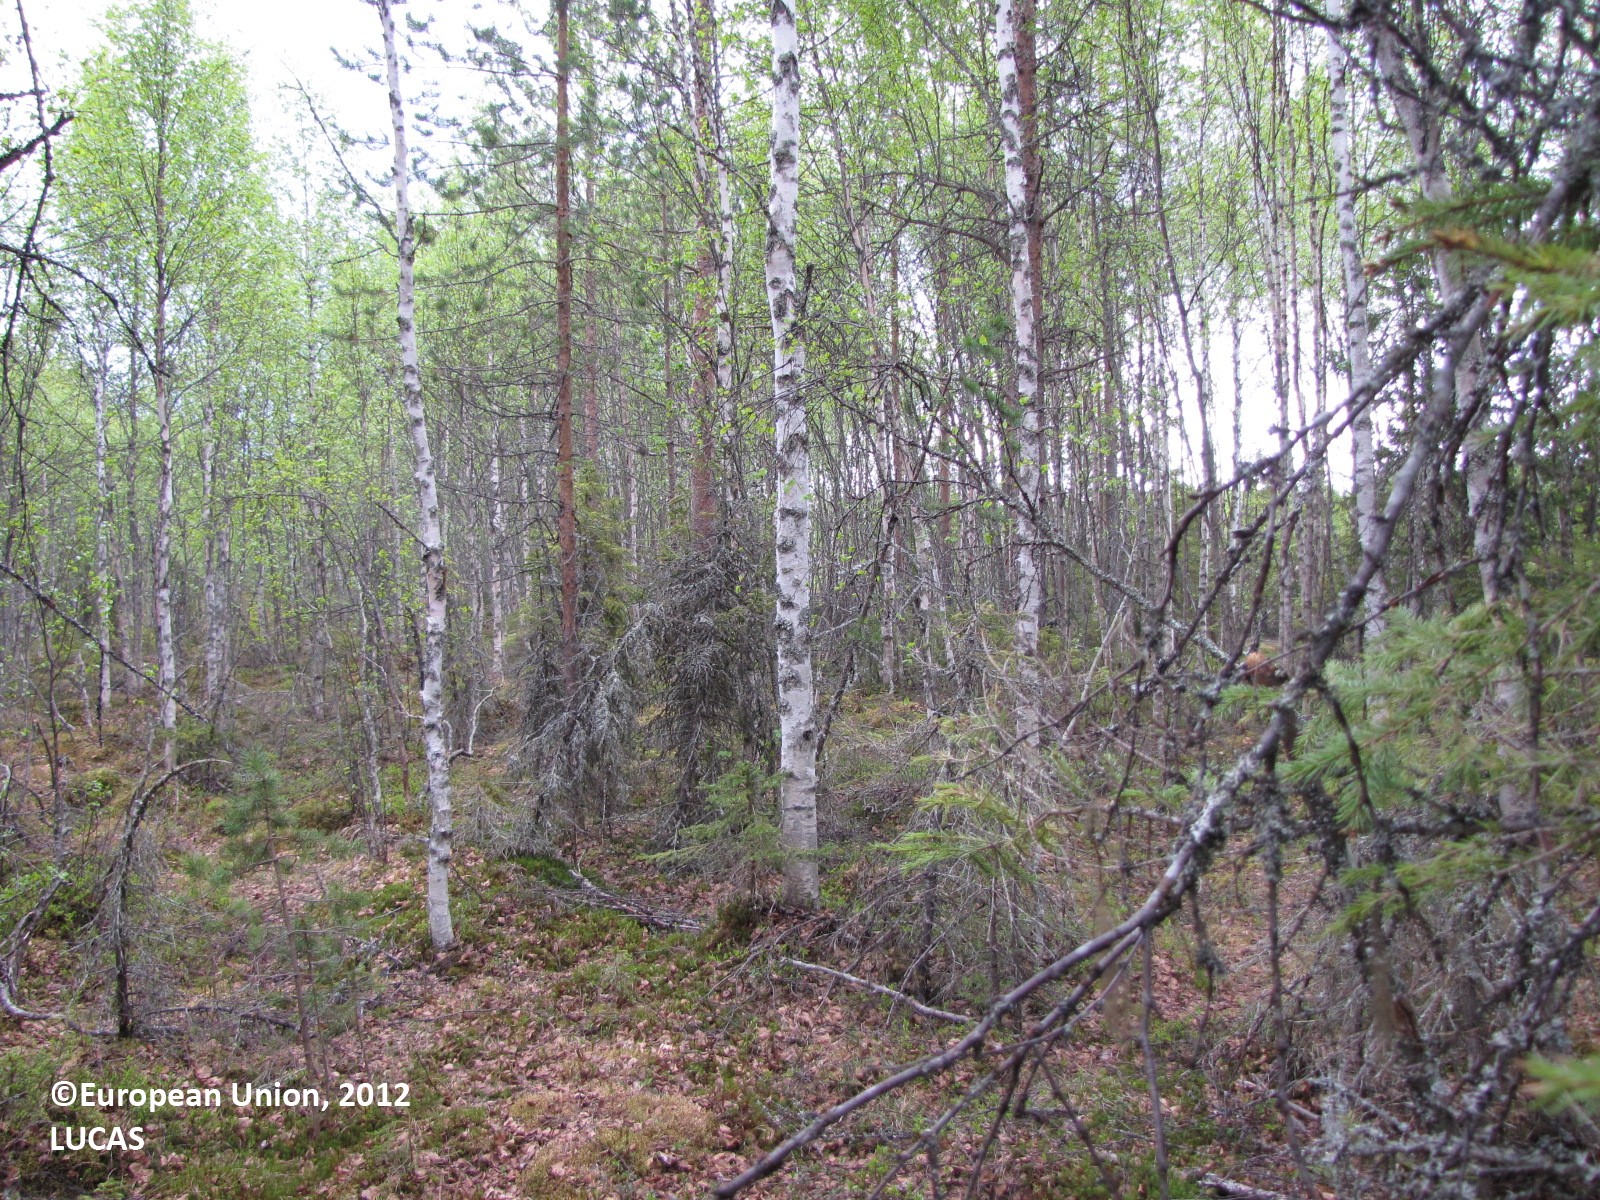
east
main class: Woodland
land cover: Other mixed woodland
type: boreal forest
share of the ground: 50 - 75 %
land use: Forestry
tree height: > 5 m
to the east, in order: Other mixed woodland; Broadleaved woodland; Ditches and canals; Broadleaved woodland; Ditches and canals; Broadleaved woodland; Ditches and canals; Broadleaved woodland; Ditches and canals; Broadleaved woodland; Ditches and canals; Broadleaved woodland; Ditches and canals; Broadleaved woodland
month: June
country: FI
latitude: 65.9015
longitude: 24.7405
